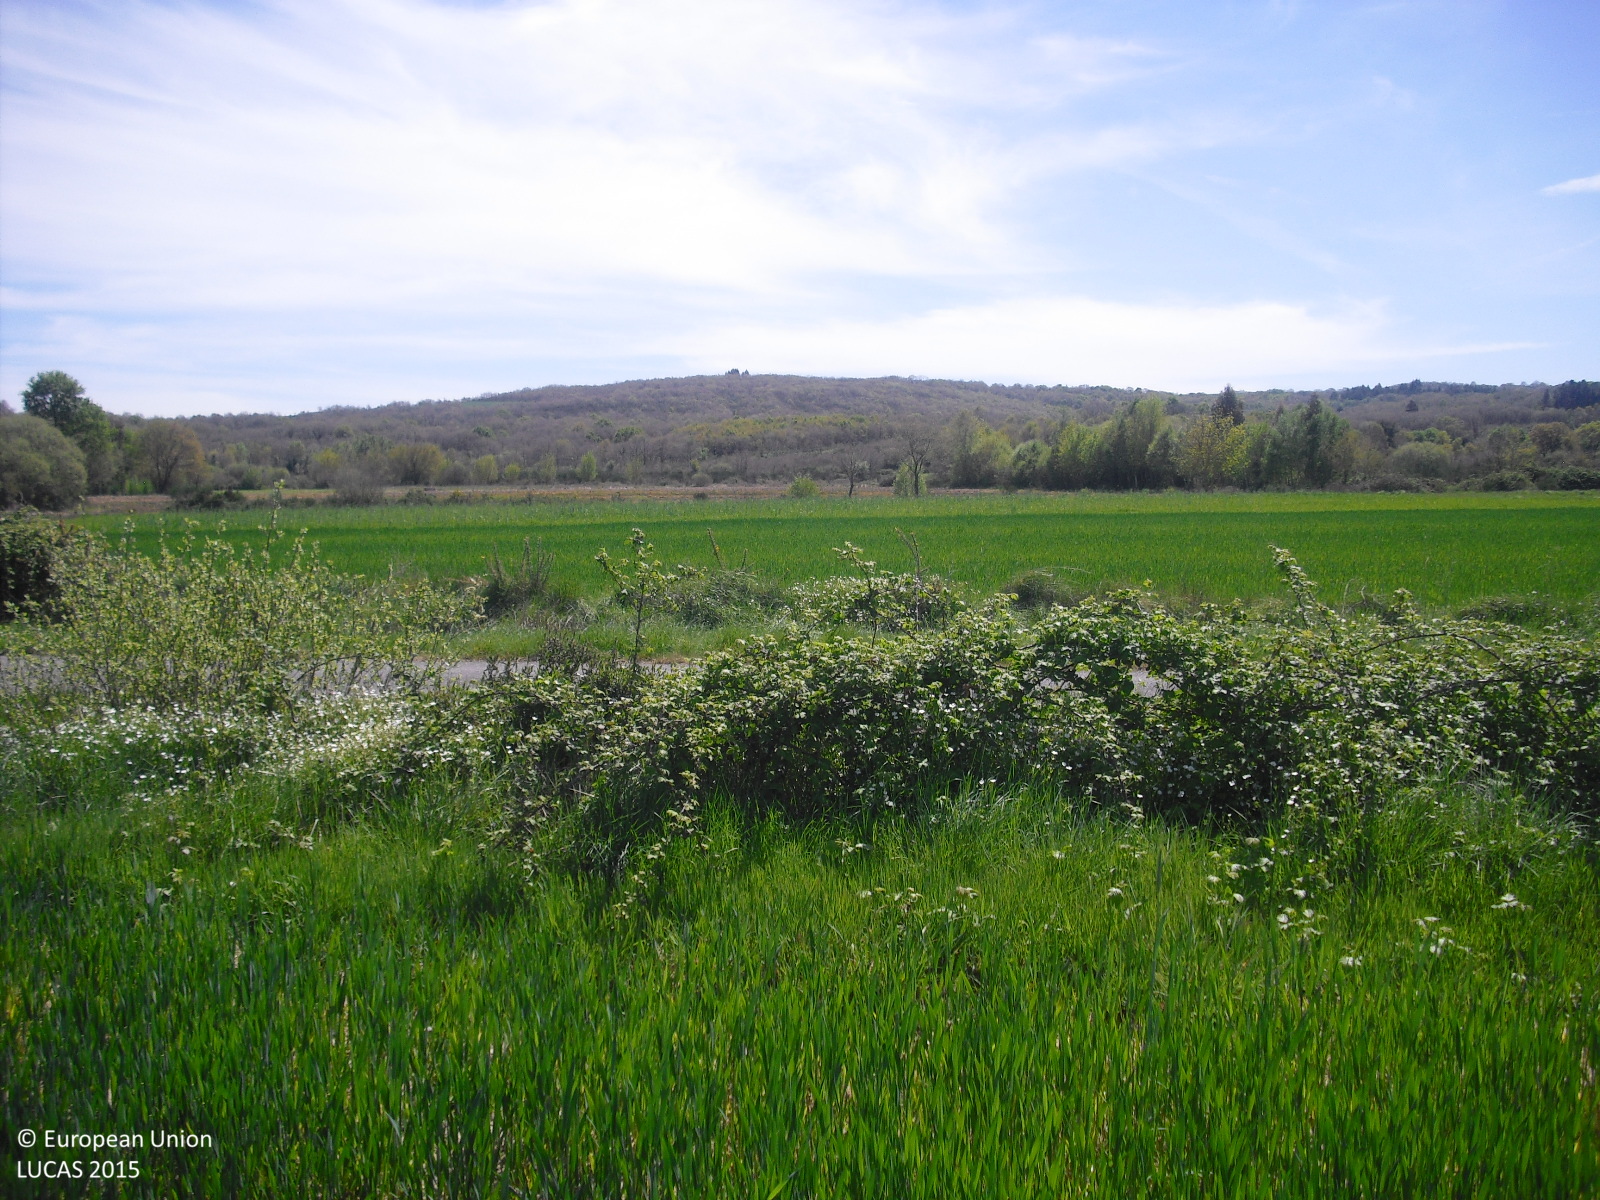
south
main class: Cropland
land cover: Common wheat
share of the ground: < 10 %
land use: Agriculture (excluding fallow land and kitchen gardens)
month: April
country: ES
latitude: 42.0365
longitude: -7.7173
